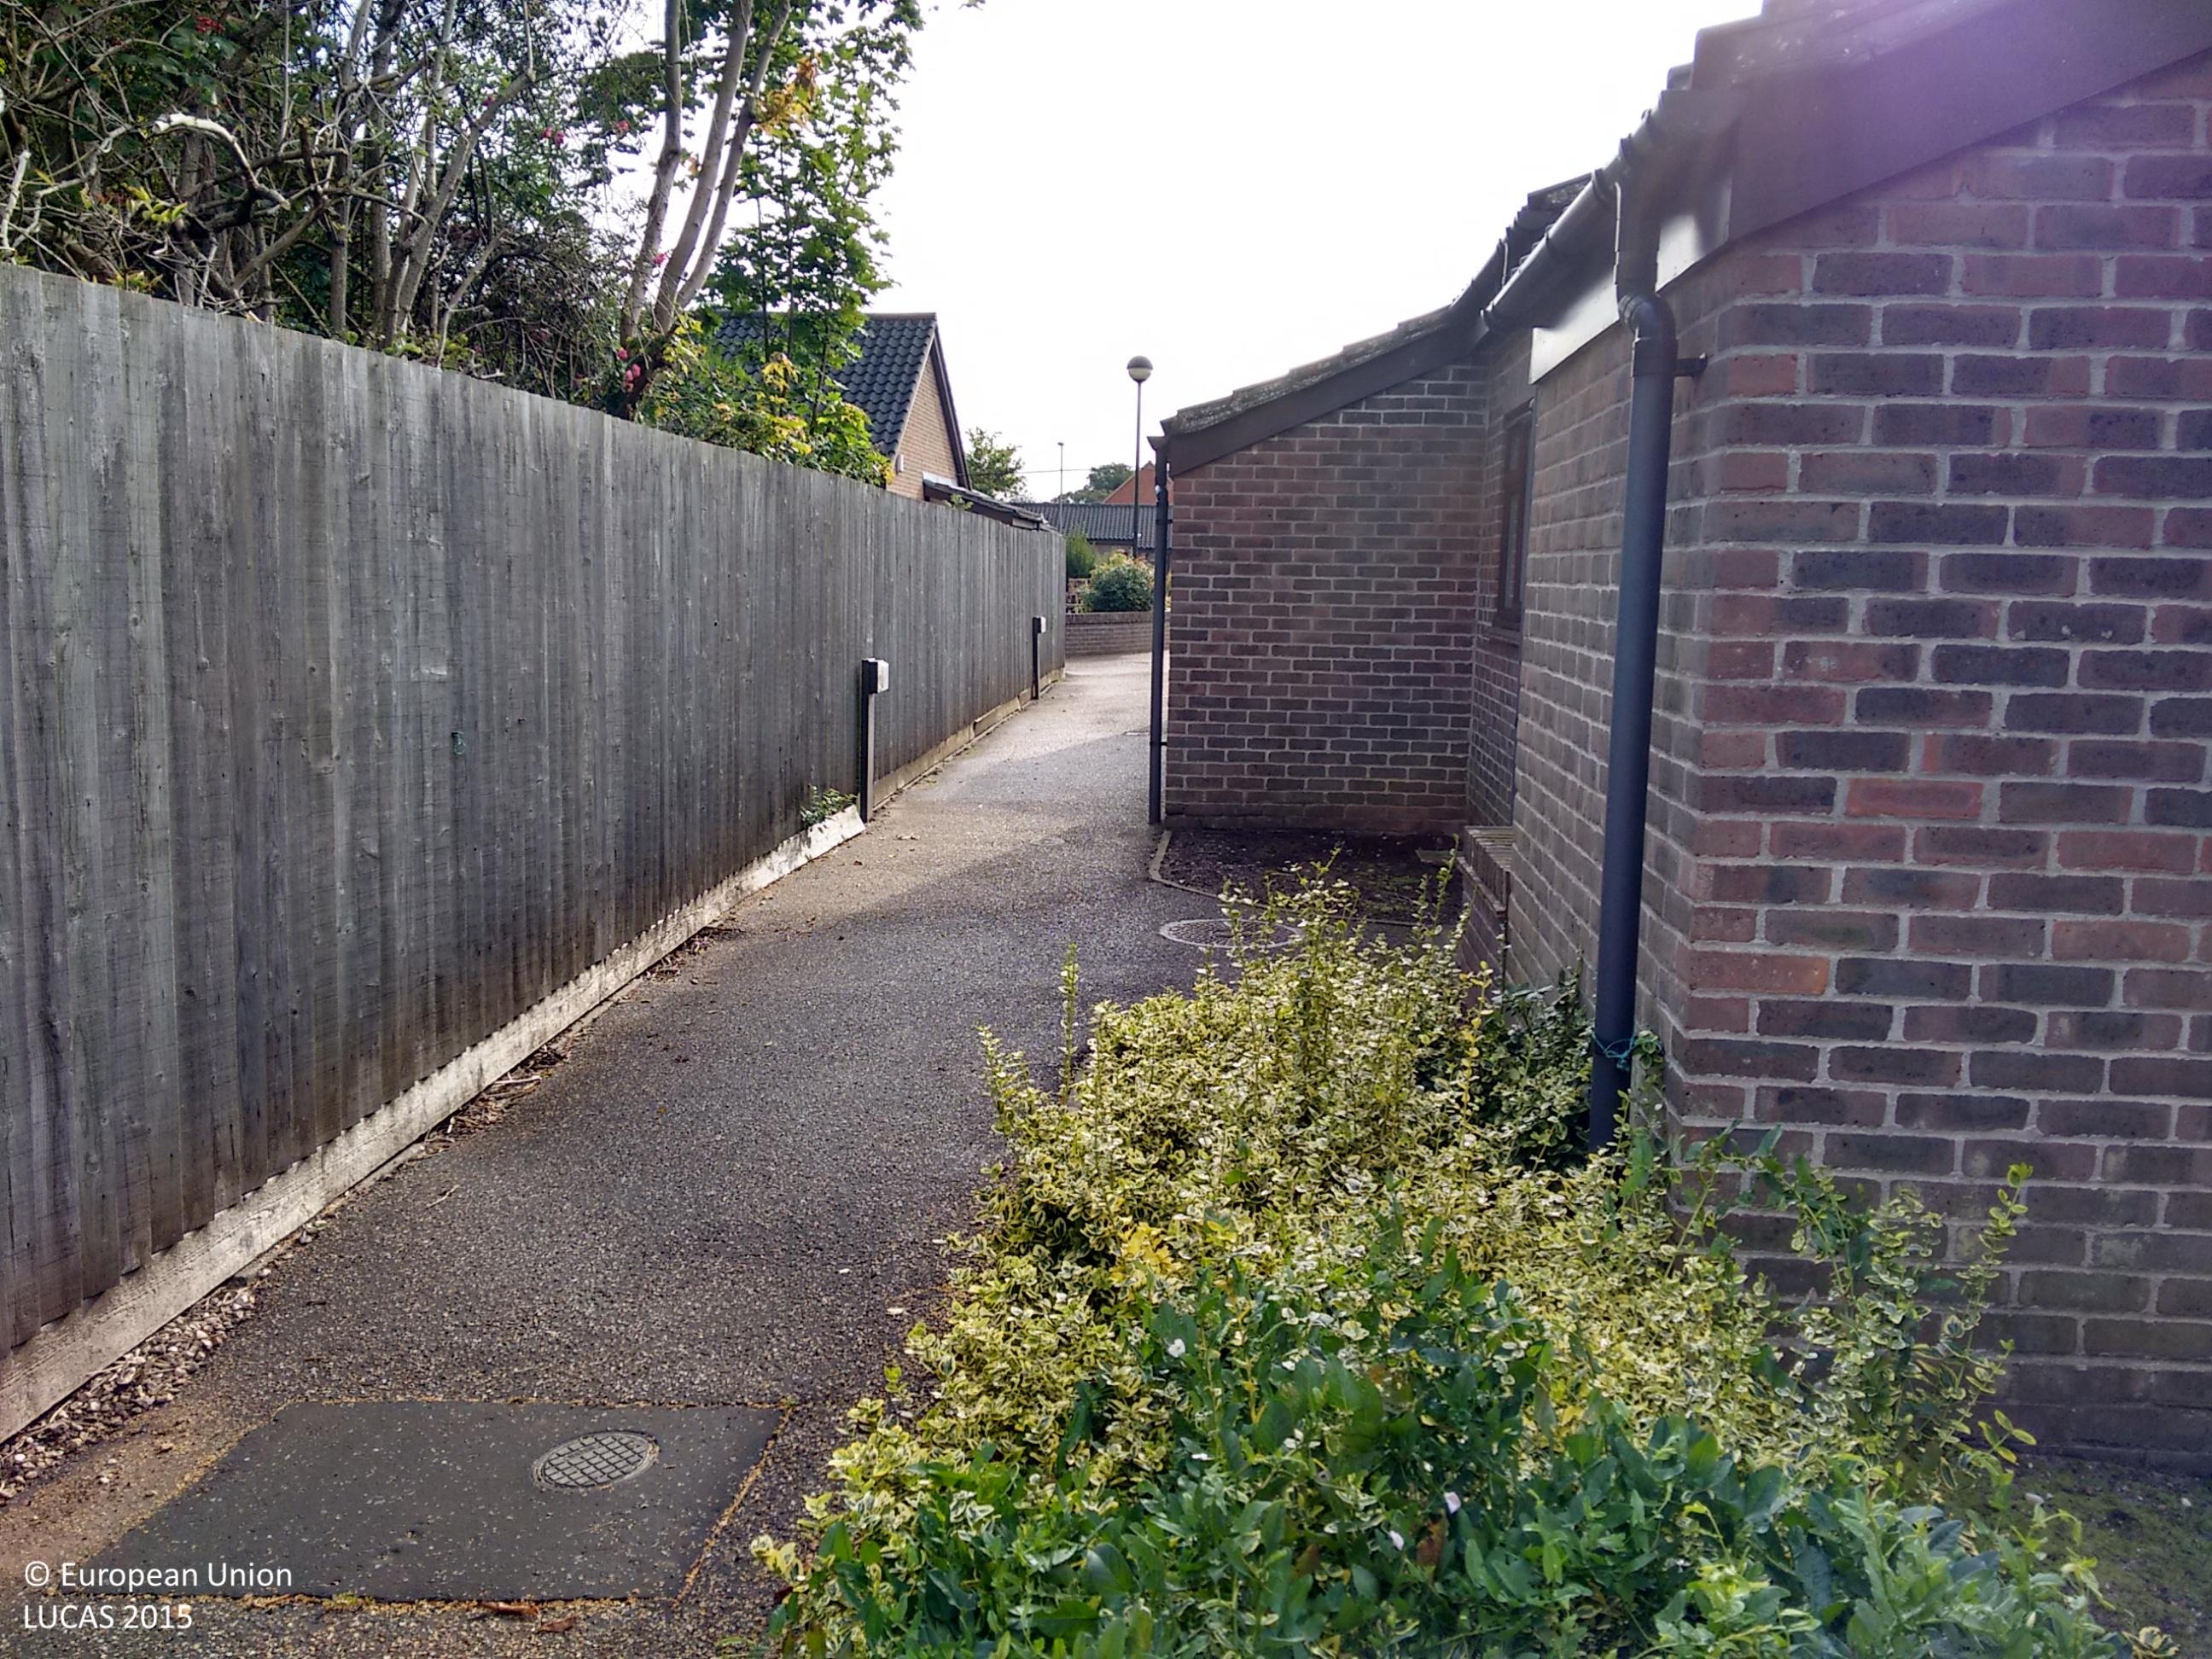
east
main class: Grassland
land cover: Grassland with sparse tree/shrub cover
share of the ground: > 75 %
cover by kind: herbaceous plants 95 %, broadleaved forest trees 5 %
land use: Residential
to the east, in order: Grassland with sparse tree/shrub cover; Artificial constructions in urban areas
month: September
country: GB
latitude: 52.6324
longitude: 1.2469
